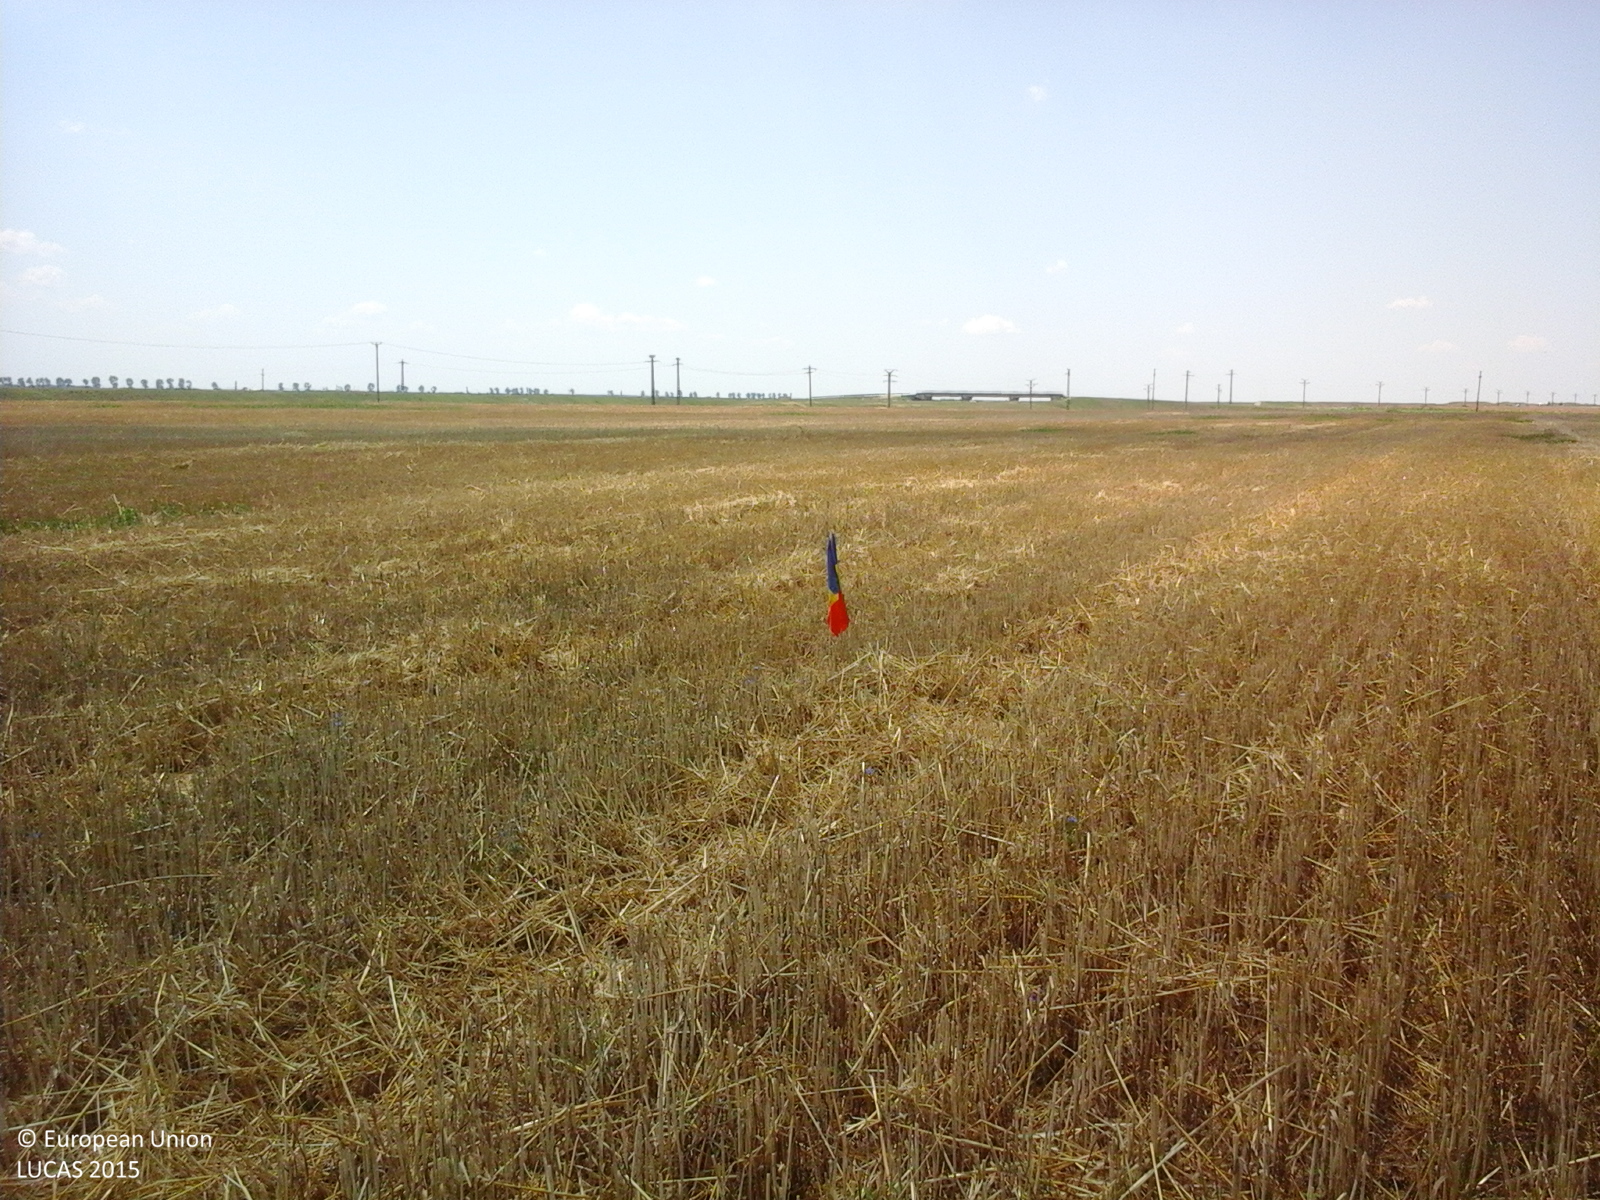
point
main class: Cropland
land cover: Common wheat
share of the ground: 50 - 75 %
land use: Agriculture (excluding fallow land and kitchen gardens)
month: July
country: RO
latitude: 44.2048
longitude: 24.6246
